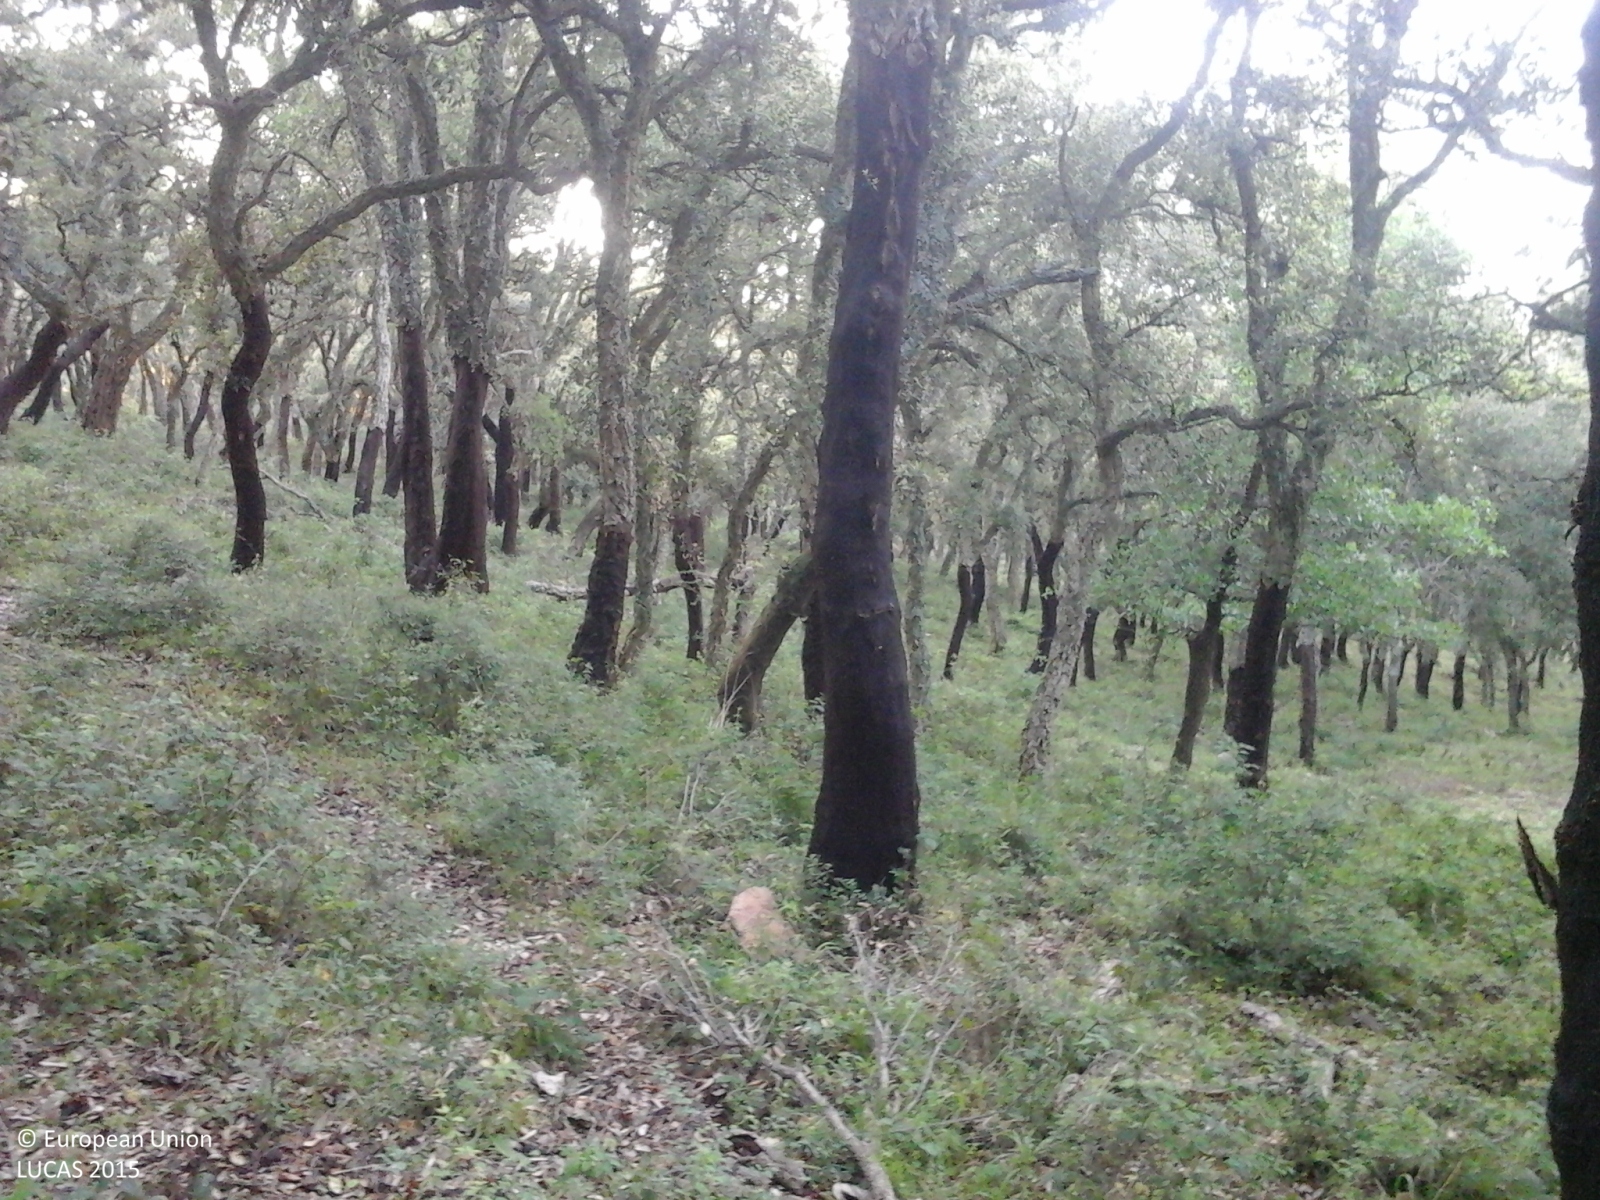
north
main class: Woodland
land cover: Broadleaved woodland
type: broadleaved evergreen forest
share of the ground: > 75 %
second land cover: Grassland without tree/shrub cover
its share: > 75 %
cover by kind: broadleaved forest trees 80 %, shrubs 10 %, herbaceous plants 5 %, consolidated bare surface 5 %
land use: Forestry
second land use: Agriculture (excluding fallow land and kitchen gardens)
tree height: > 5 m
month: May
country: IT
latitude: 37.8934
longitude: 14.1442
